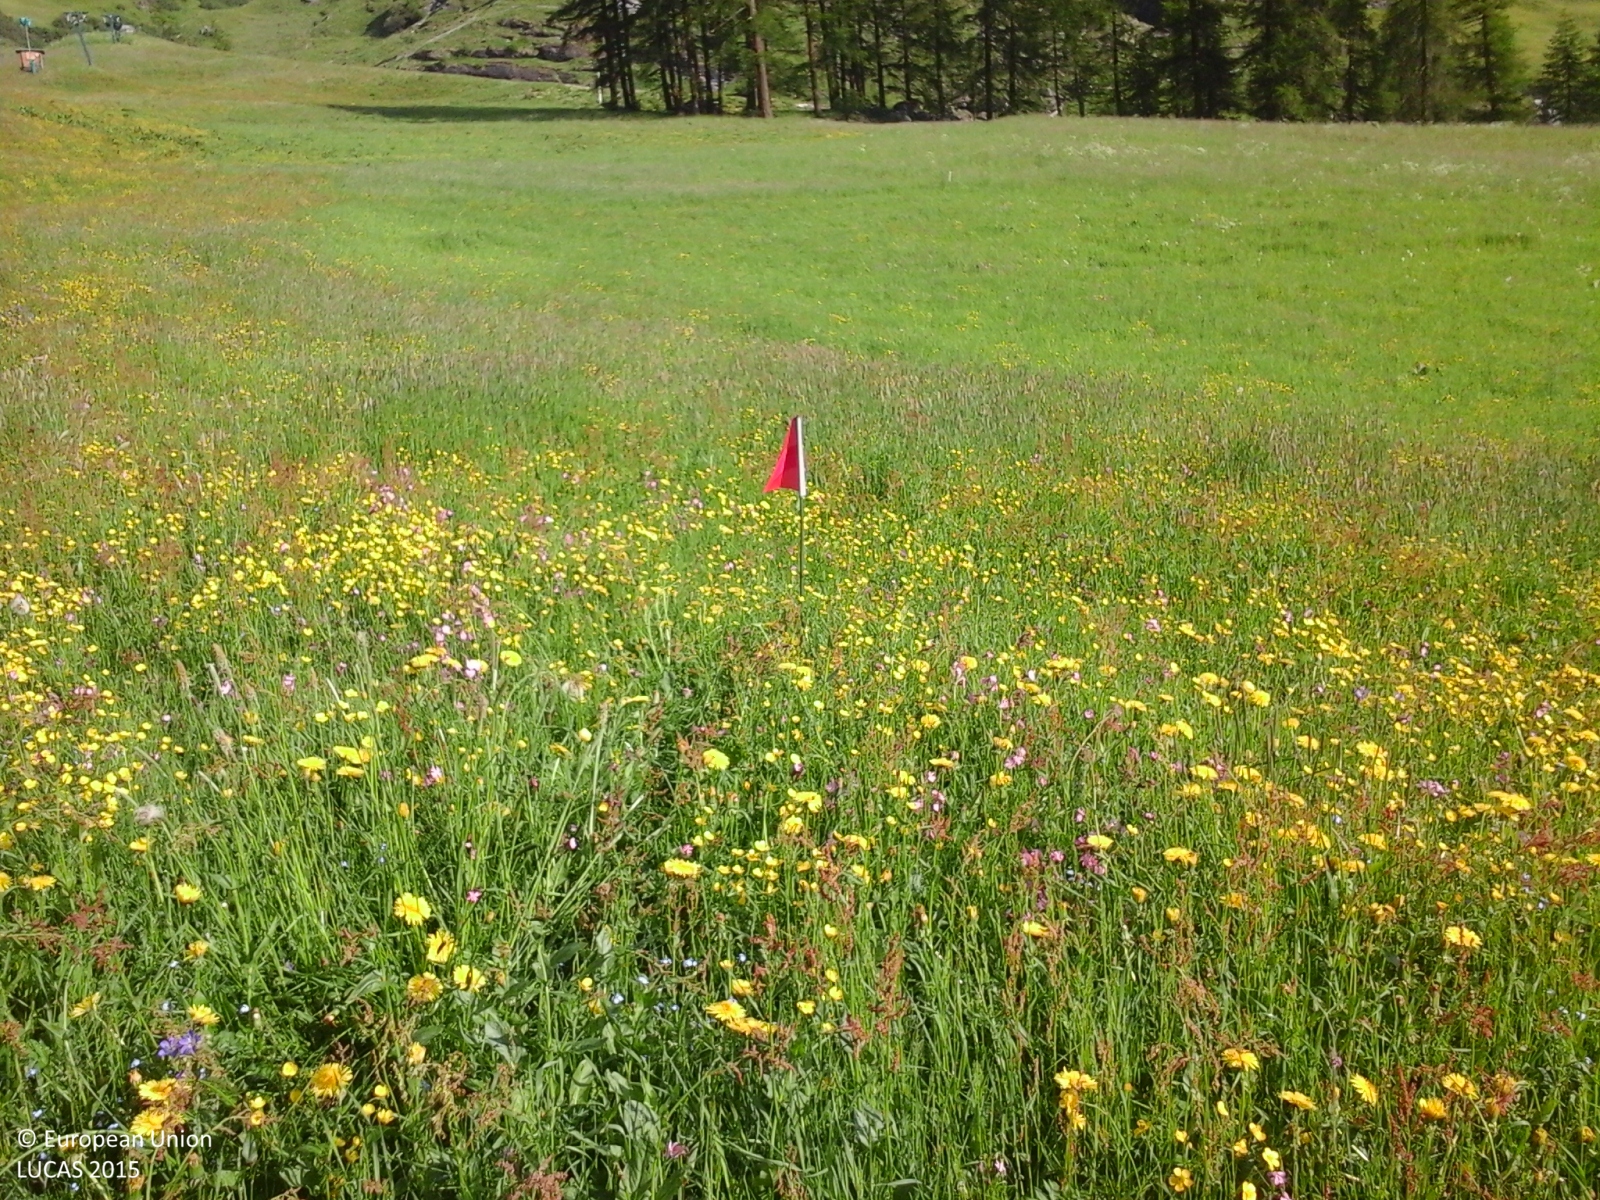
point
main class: Grassland
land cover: Grassland without tree/shrub cover
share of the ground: > 75 %
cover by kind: herbaceous plants 100 %
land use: Agriculture (excluding fallow land and kitchen gardens)
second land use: Sport
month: June
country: IT
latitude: 46.7960
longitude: 11.0862
